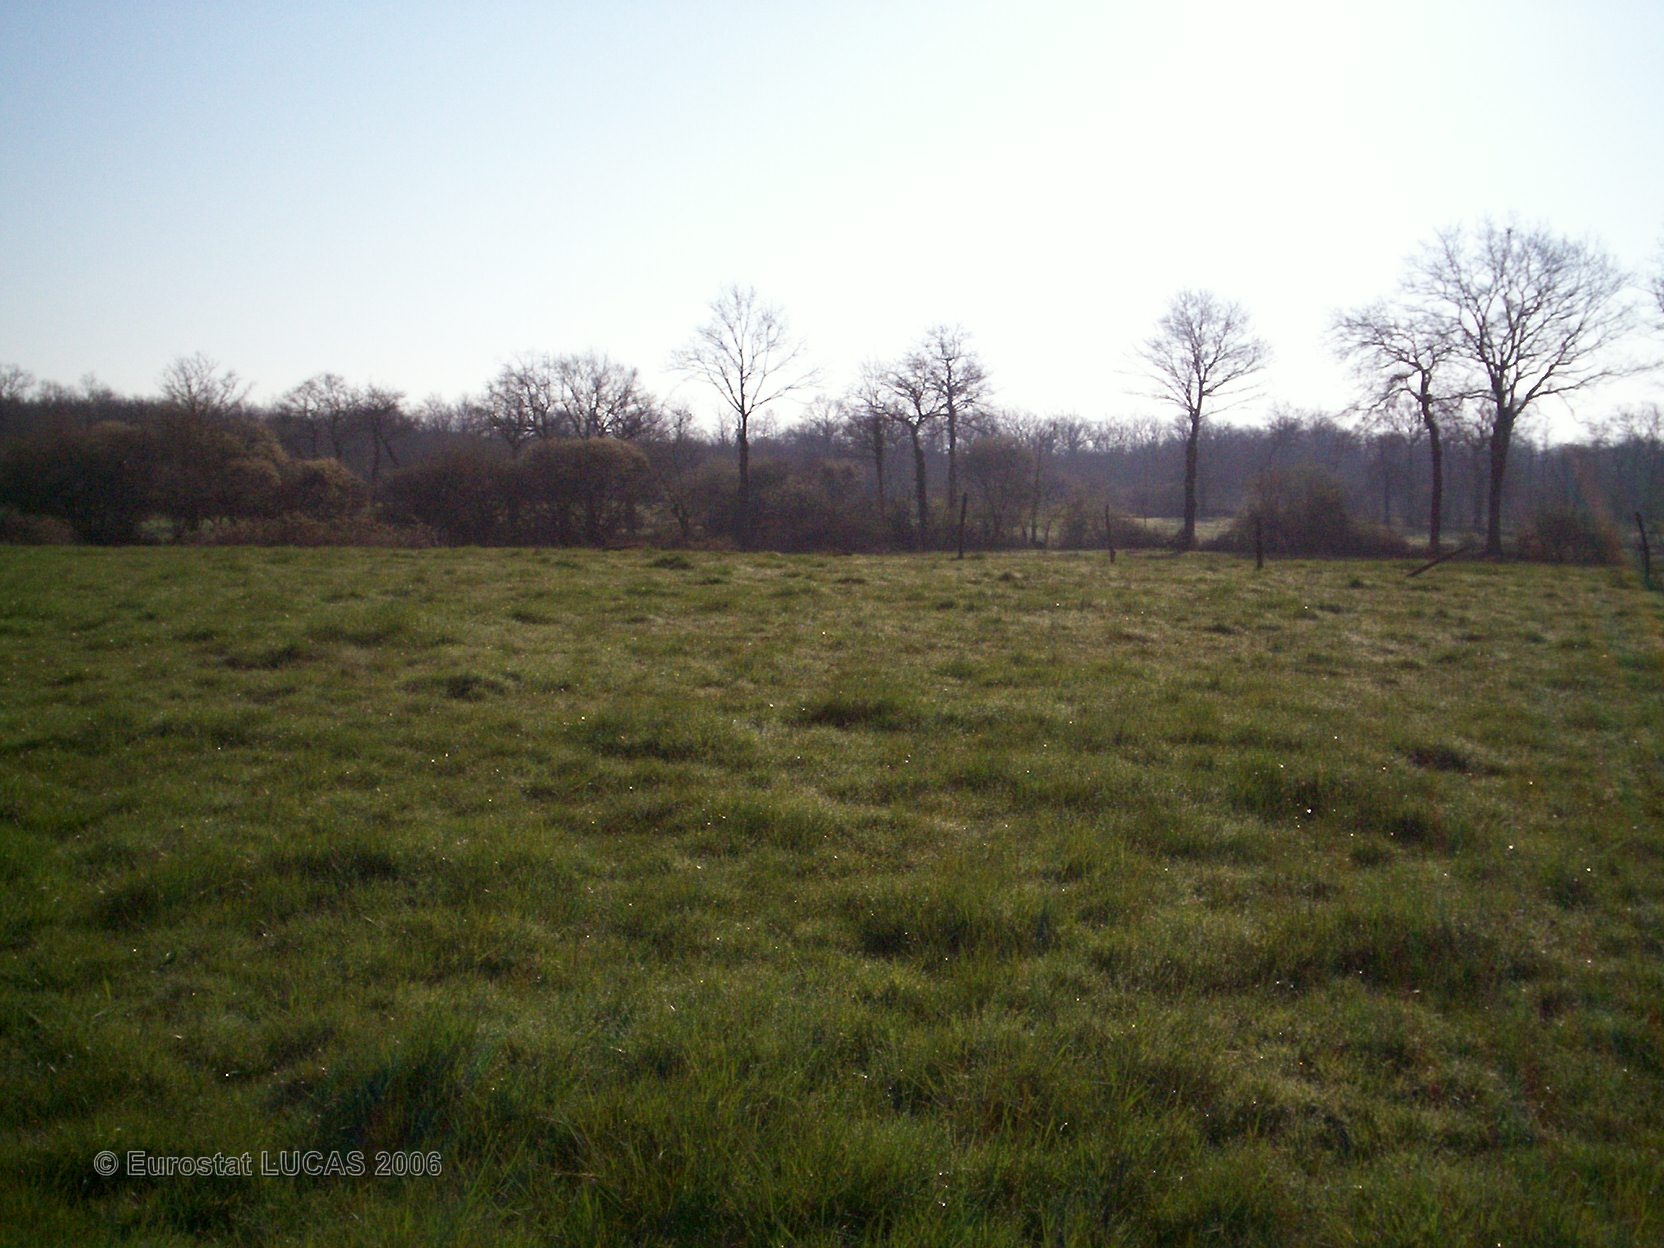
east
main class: Grassland
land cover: Grassland without tree/shrub cover
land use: Agriculture (excluding fallow land and kitchen gardens)
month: April
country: FR
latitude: 46.2694
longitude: 1.0997
